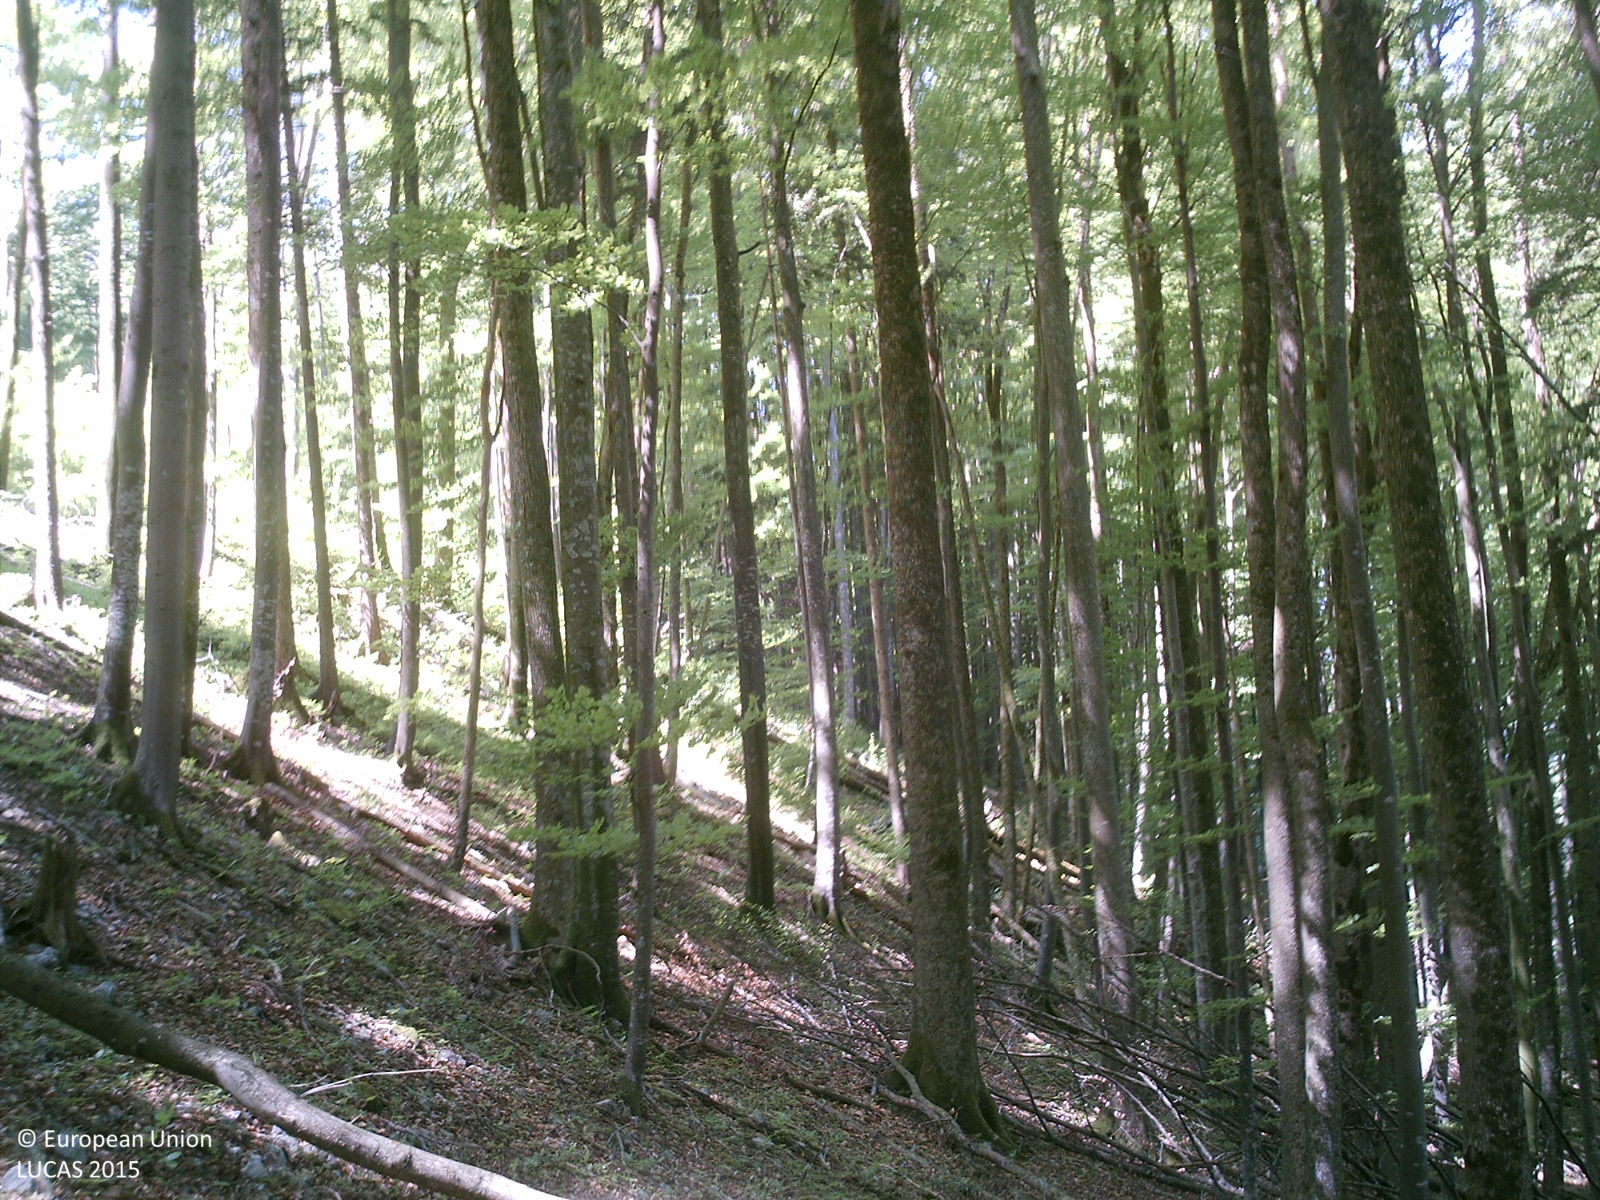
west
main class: Woodland
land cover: Broadleaved woodland
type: mountainous beech forest
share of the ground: > 75 %
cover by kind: broadleaved forest trees 90 %, shrubs 5 %, herbaceous plants 5 %
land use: Forestry
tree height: > 5 m
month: May
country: AT
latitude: 47.8579
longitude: 14.1295
